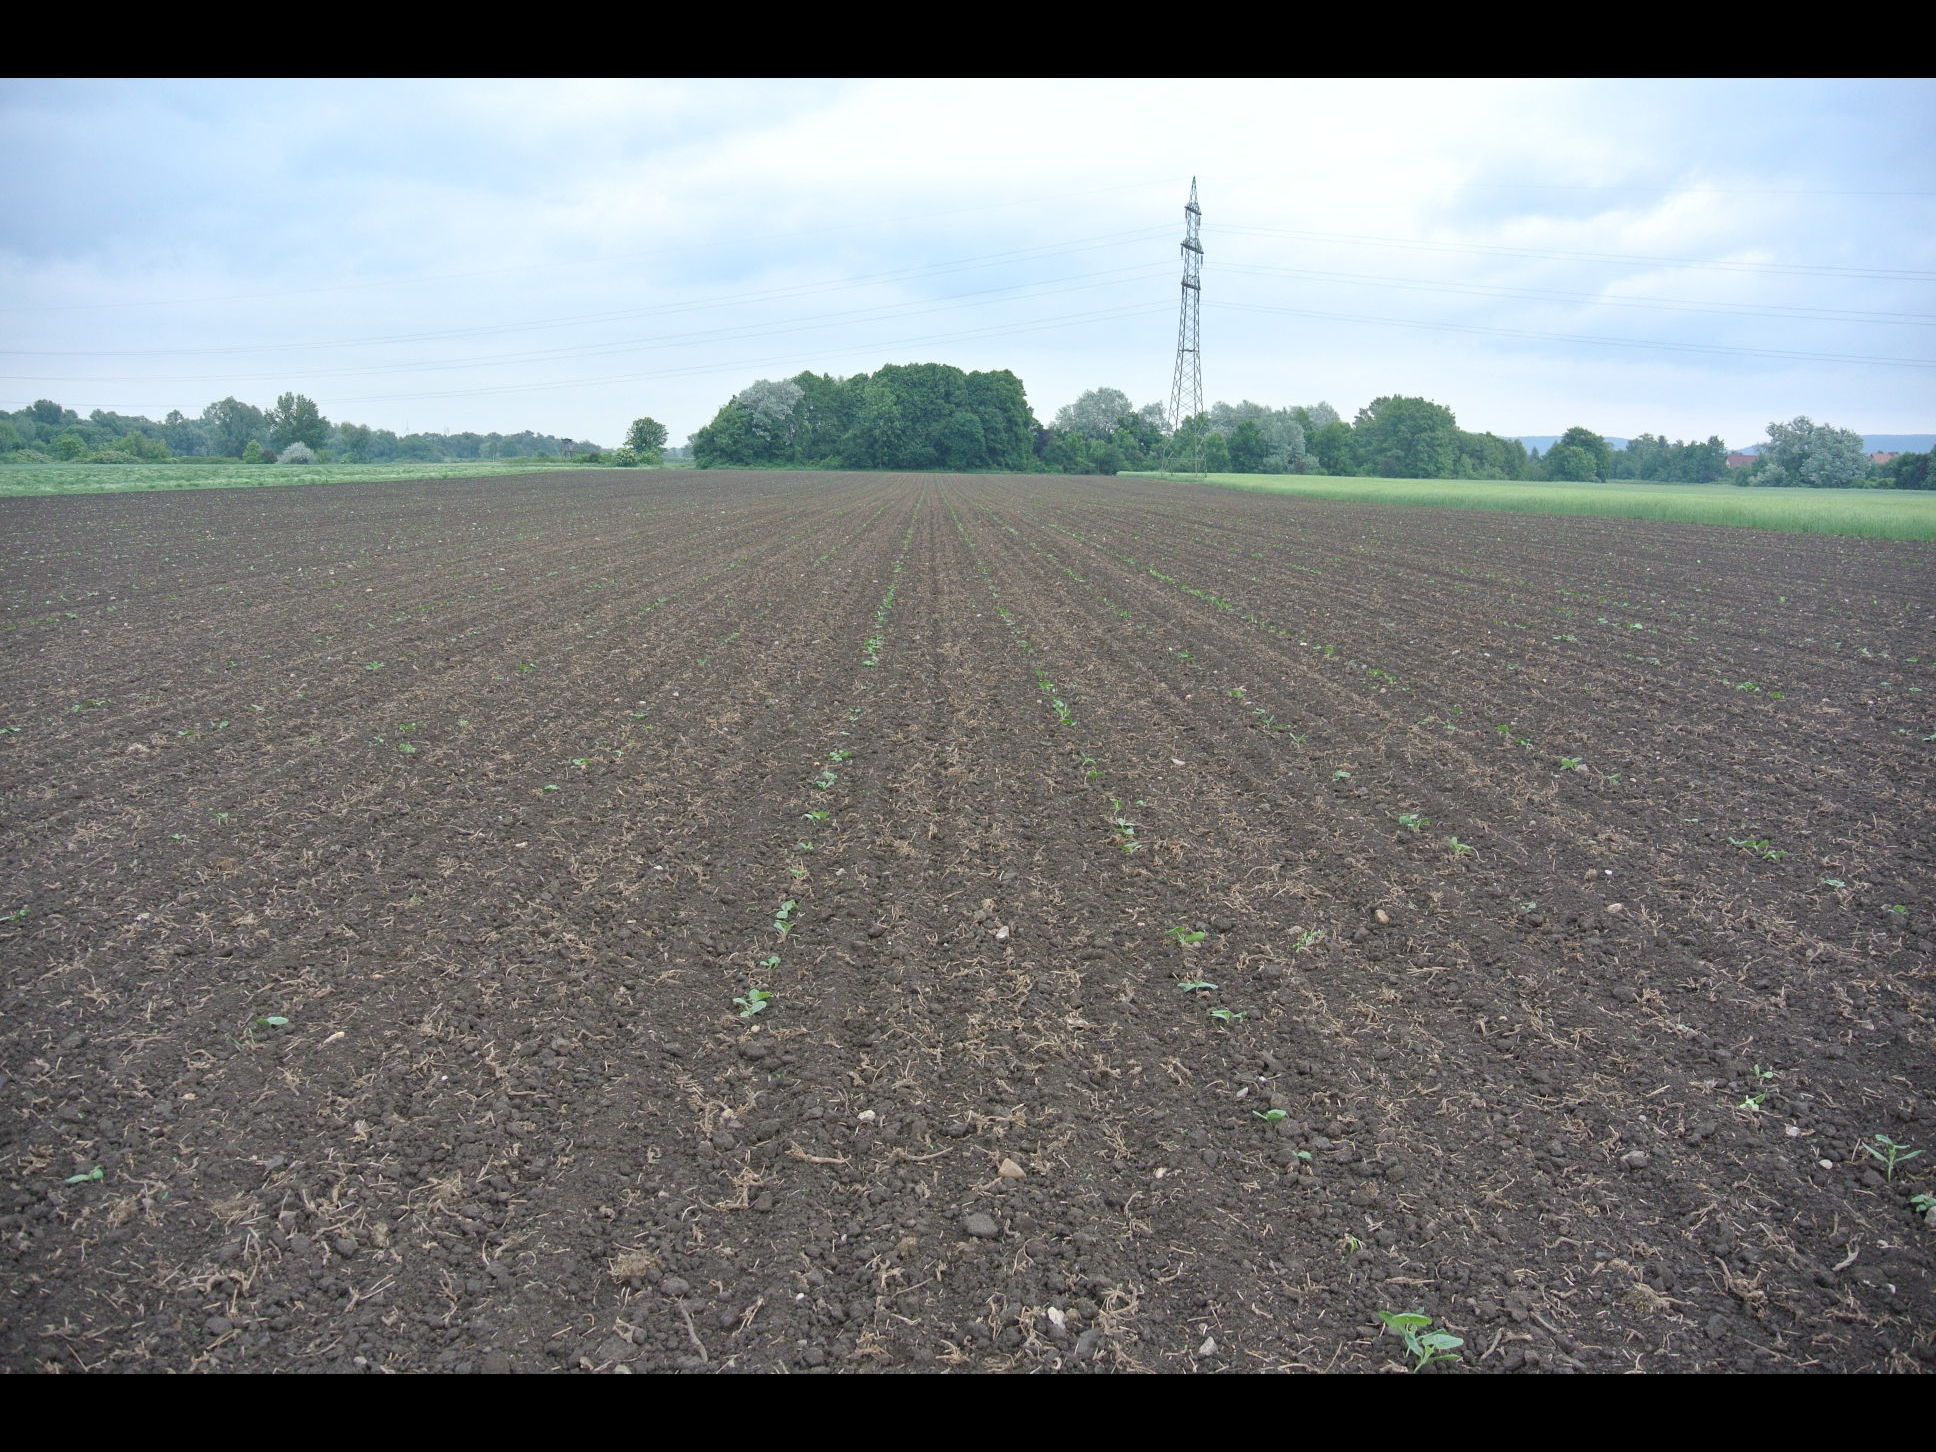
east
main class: Cropland
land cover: Other fibre and oleaginous crops
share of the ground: < 10 %
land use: Agriculture (excluding fallow land and kitchen gardens)
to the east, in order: Other fibre and oleaginous crops; Electric lines; Other fibre and oleaginous crops
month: May
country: AT
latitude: 48.0084
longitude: 16.5871
